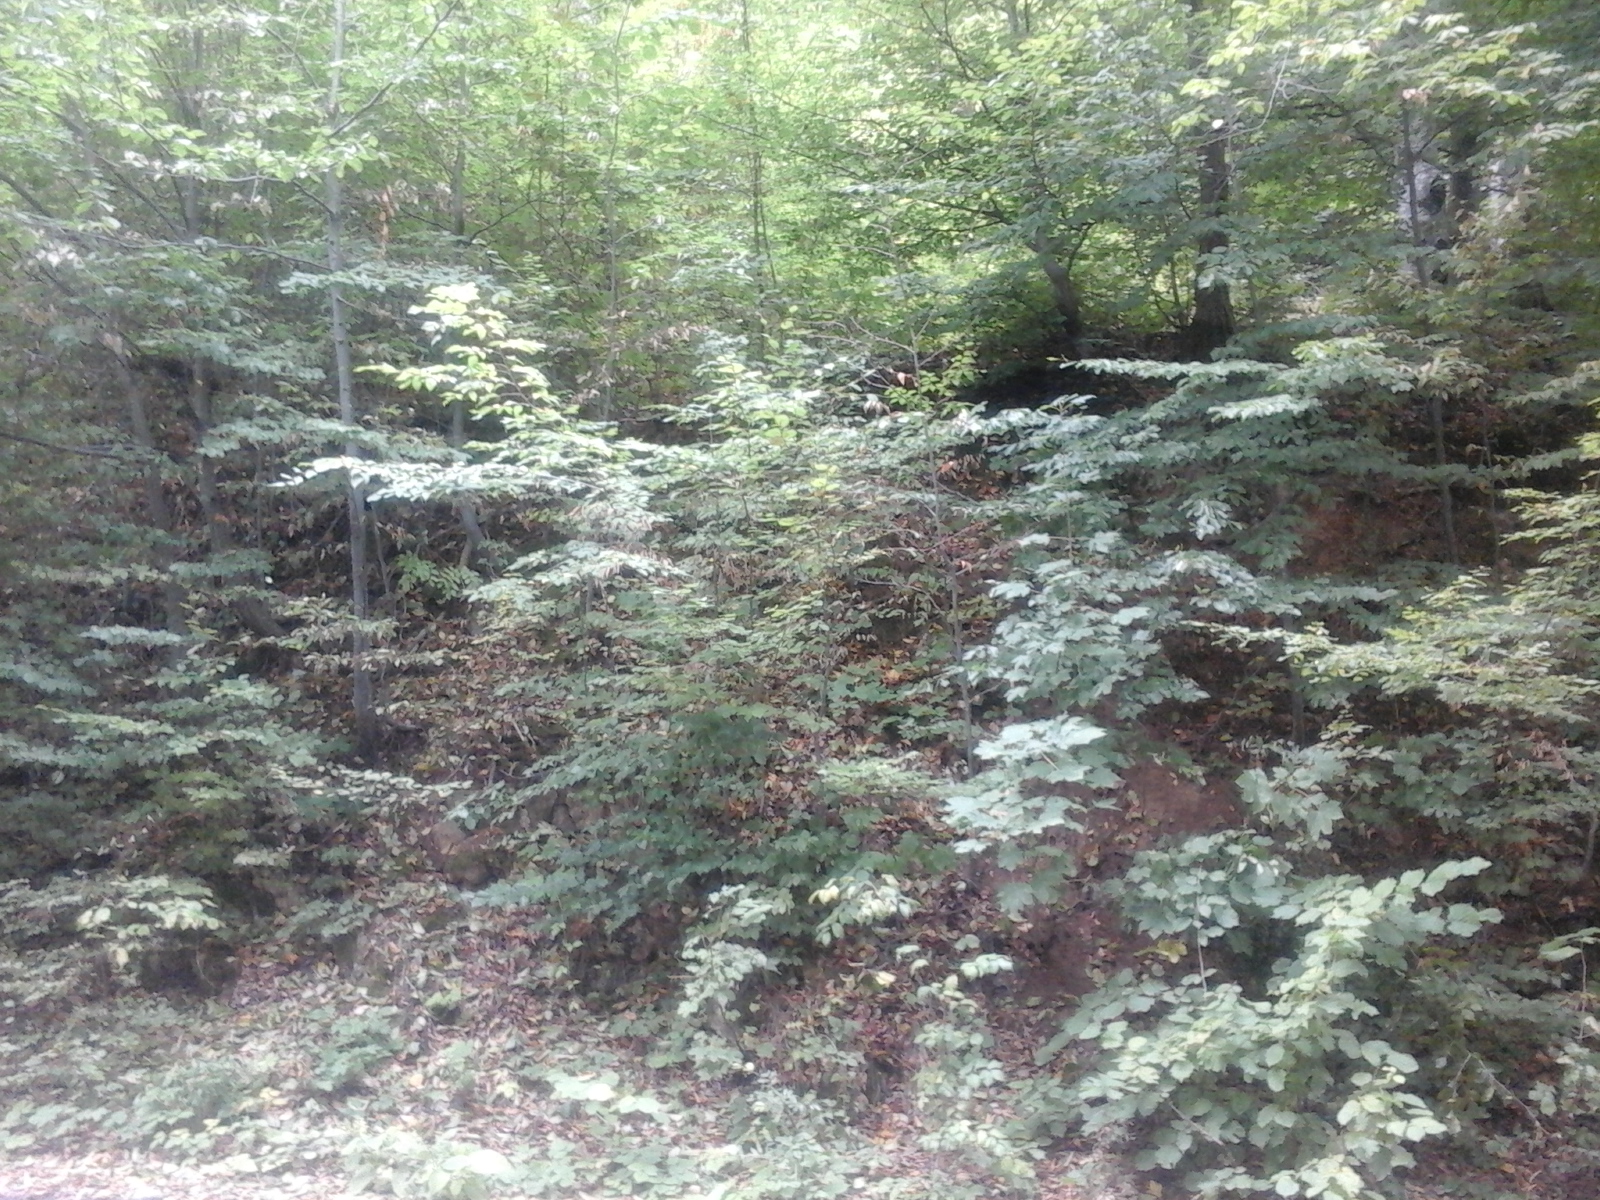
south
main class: Woodland
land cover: Broadleaved woodland
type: beech forest
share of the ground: > 75 %
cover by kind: broadleaved forest trees 100 %
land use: Forestry
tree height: > 5 m
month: August
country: RO
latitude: 45.1056
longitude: 21.8666
